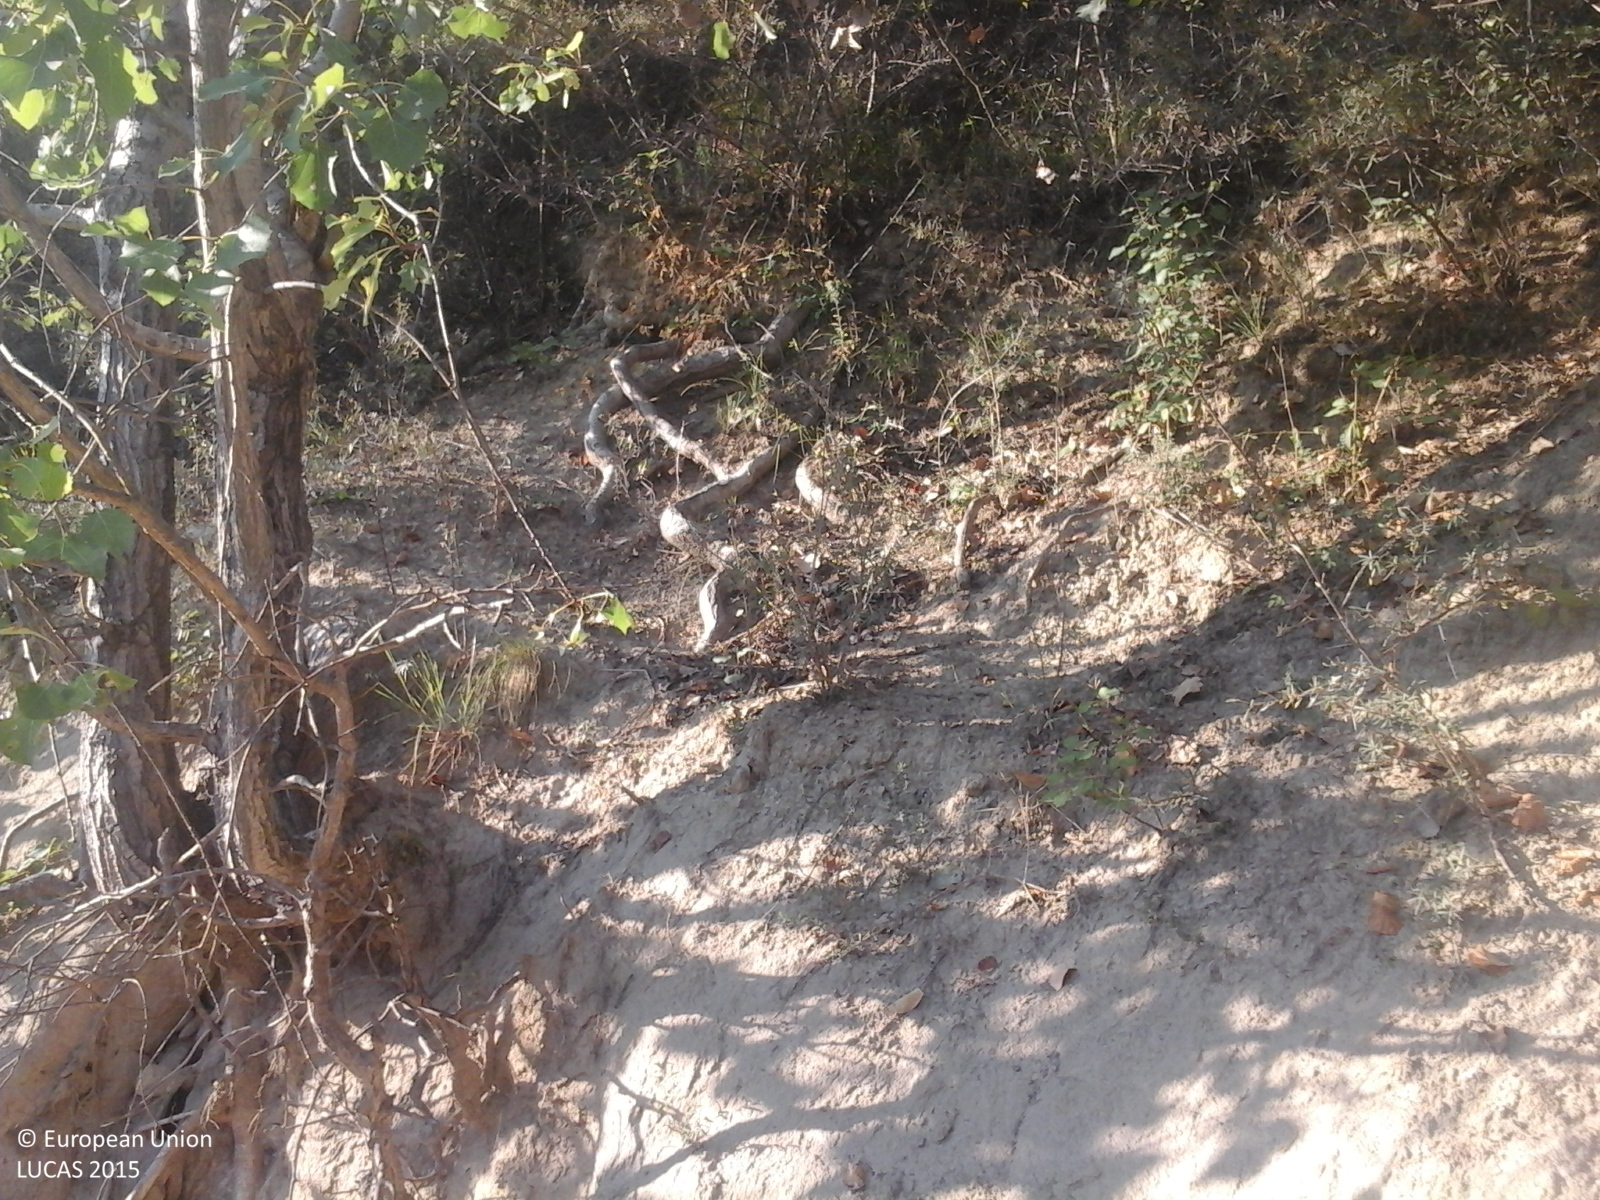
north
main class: Woodland
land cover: Broadleaved woodland
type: beech forest
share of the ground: > 75 %
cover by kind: broadleaved forest trees 100 %
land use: Forestry
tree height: > 5 m
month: August
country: RO
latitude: 46.3068
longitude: 26.8531
